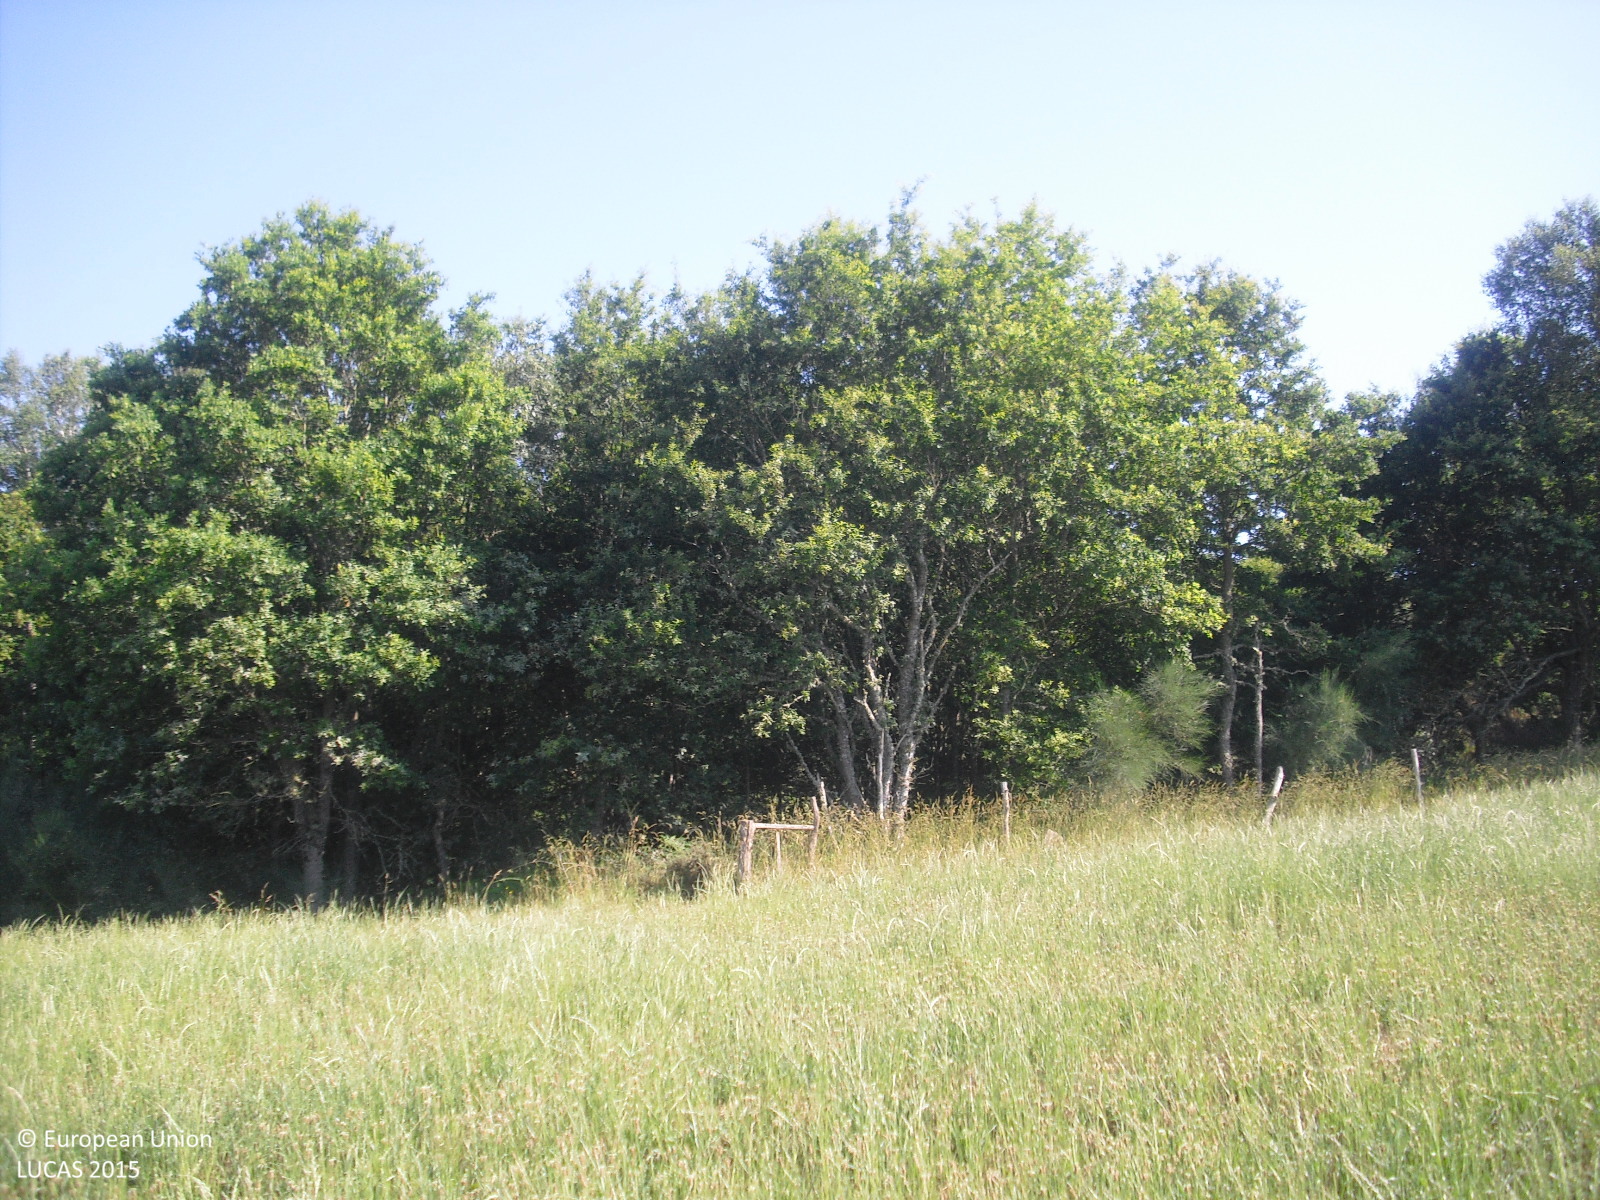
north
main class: Cropland
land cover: Temporary grasslands
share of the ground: > 75 %
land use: Agriculture (excluding fallow land and kitchen gardens)
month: June
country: ES
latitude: 42.5476
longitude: -7.7465
